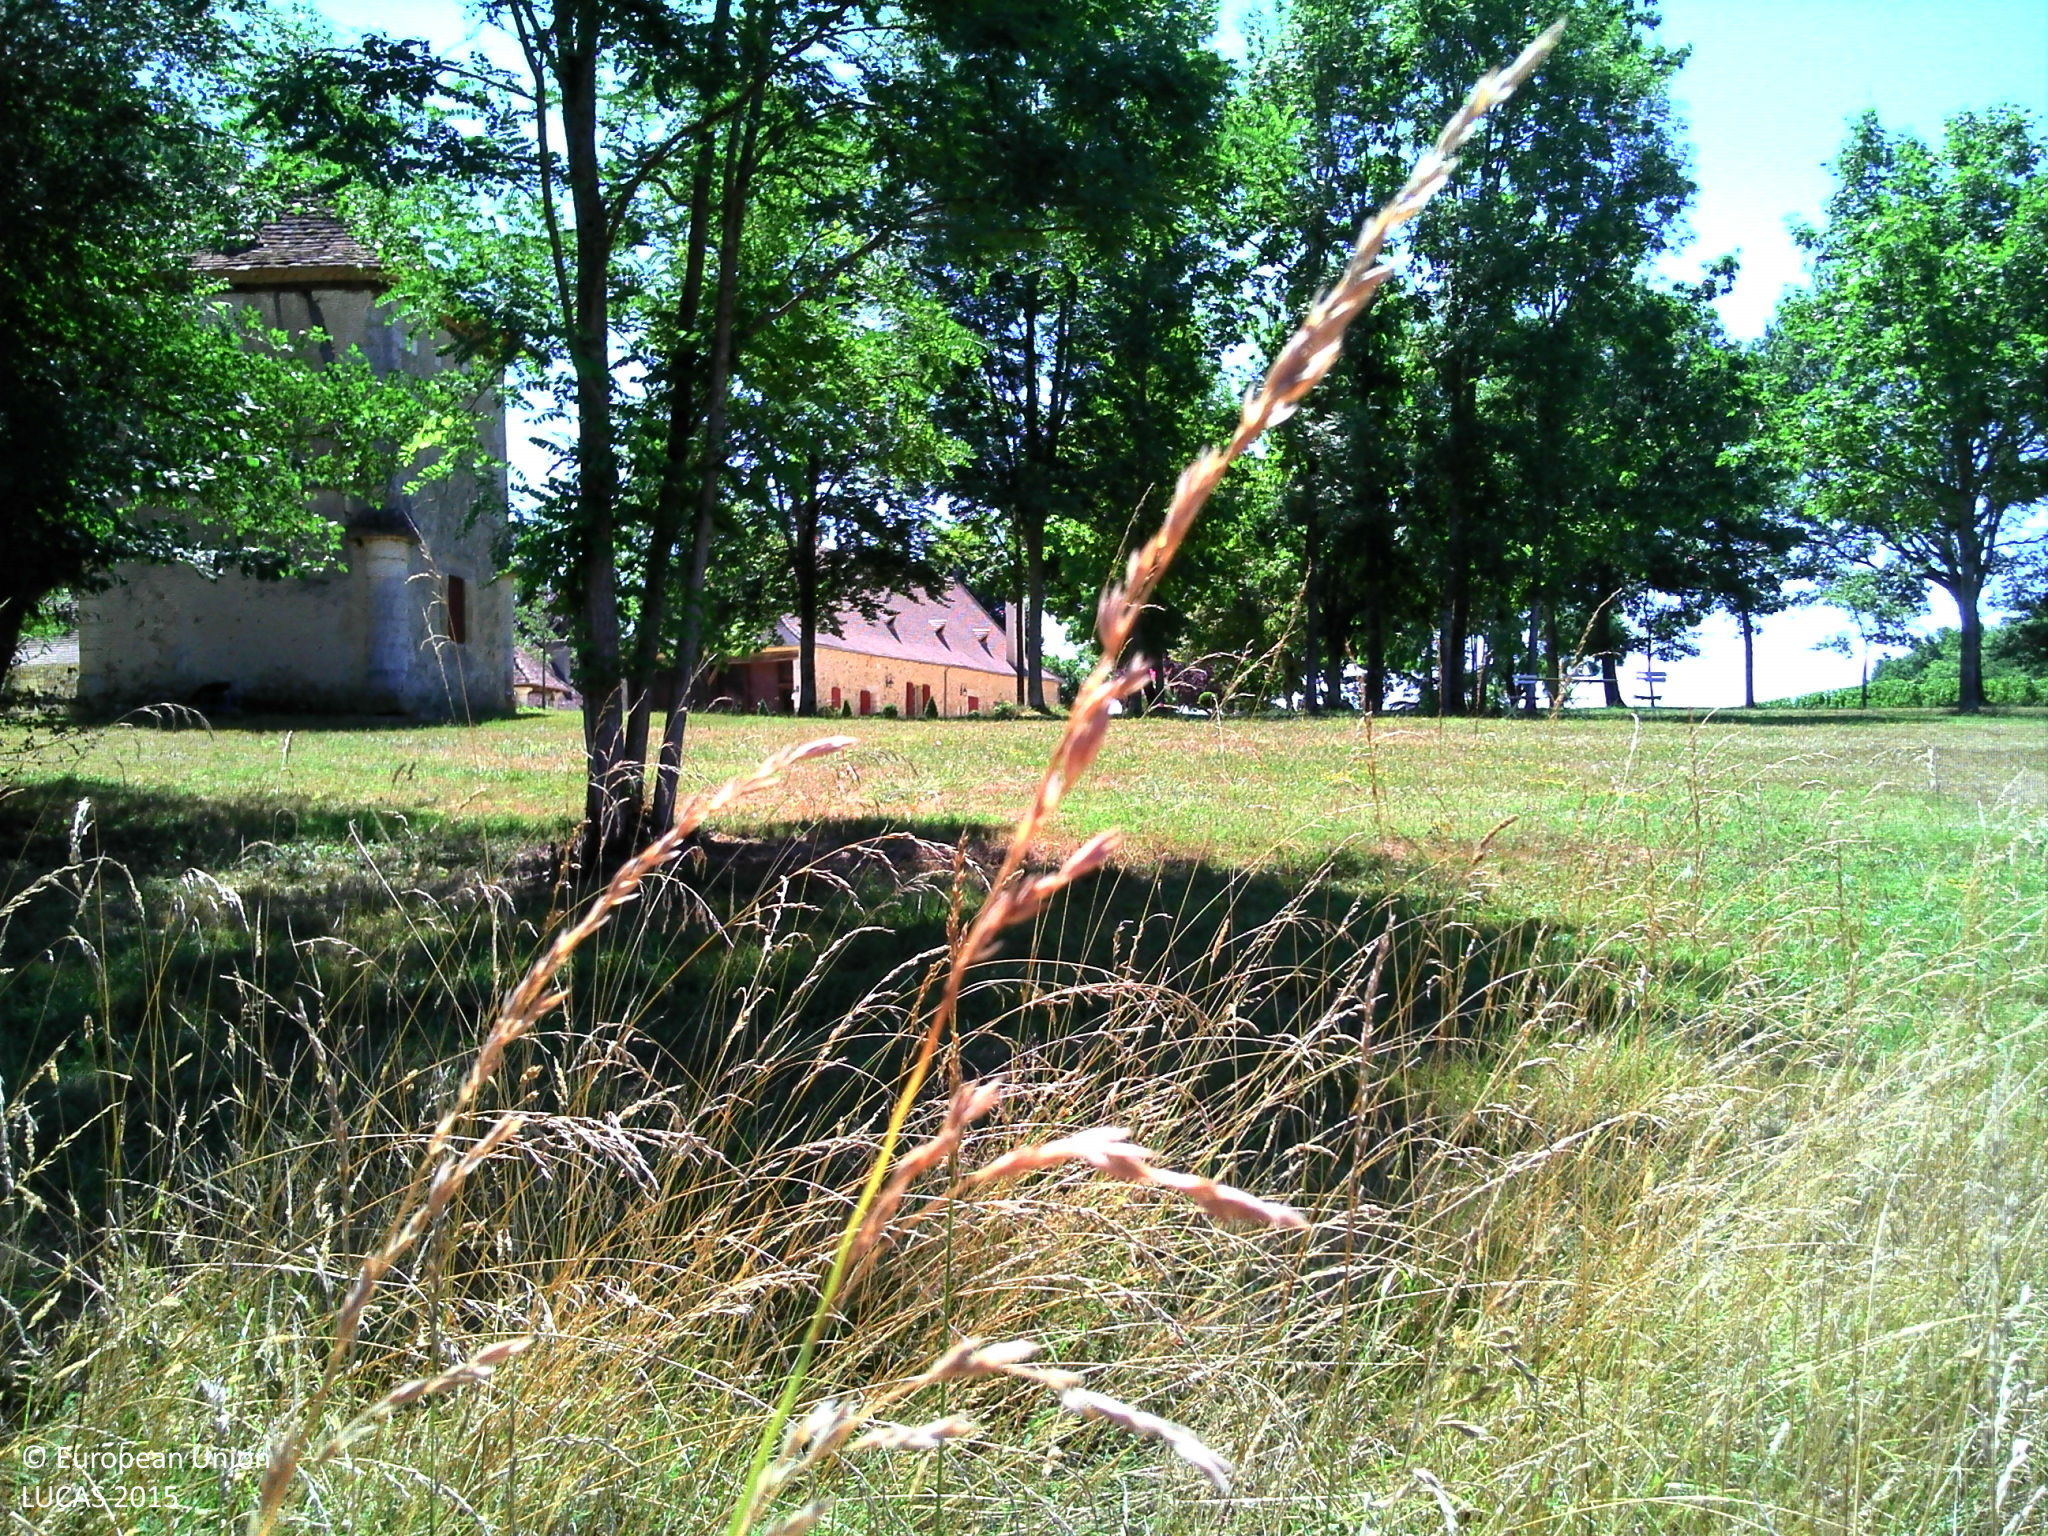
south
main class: Grassland
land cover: Grassland without tree/shrub cover
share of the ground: > 75 %
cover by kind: herbaceous plants 100 %
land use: Agriculture (excluding fallow land and kitchen gardens)
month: July
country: FR
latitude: 44.8810
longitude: 0.5591
